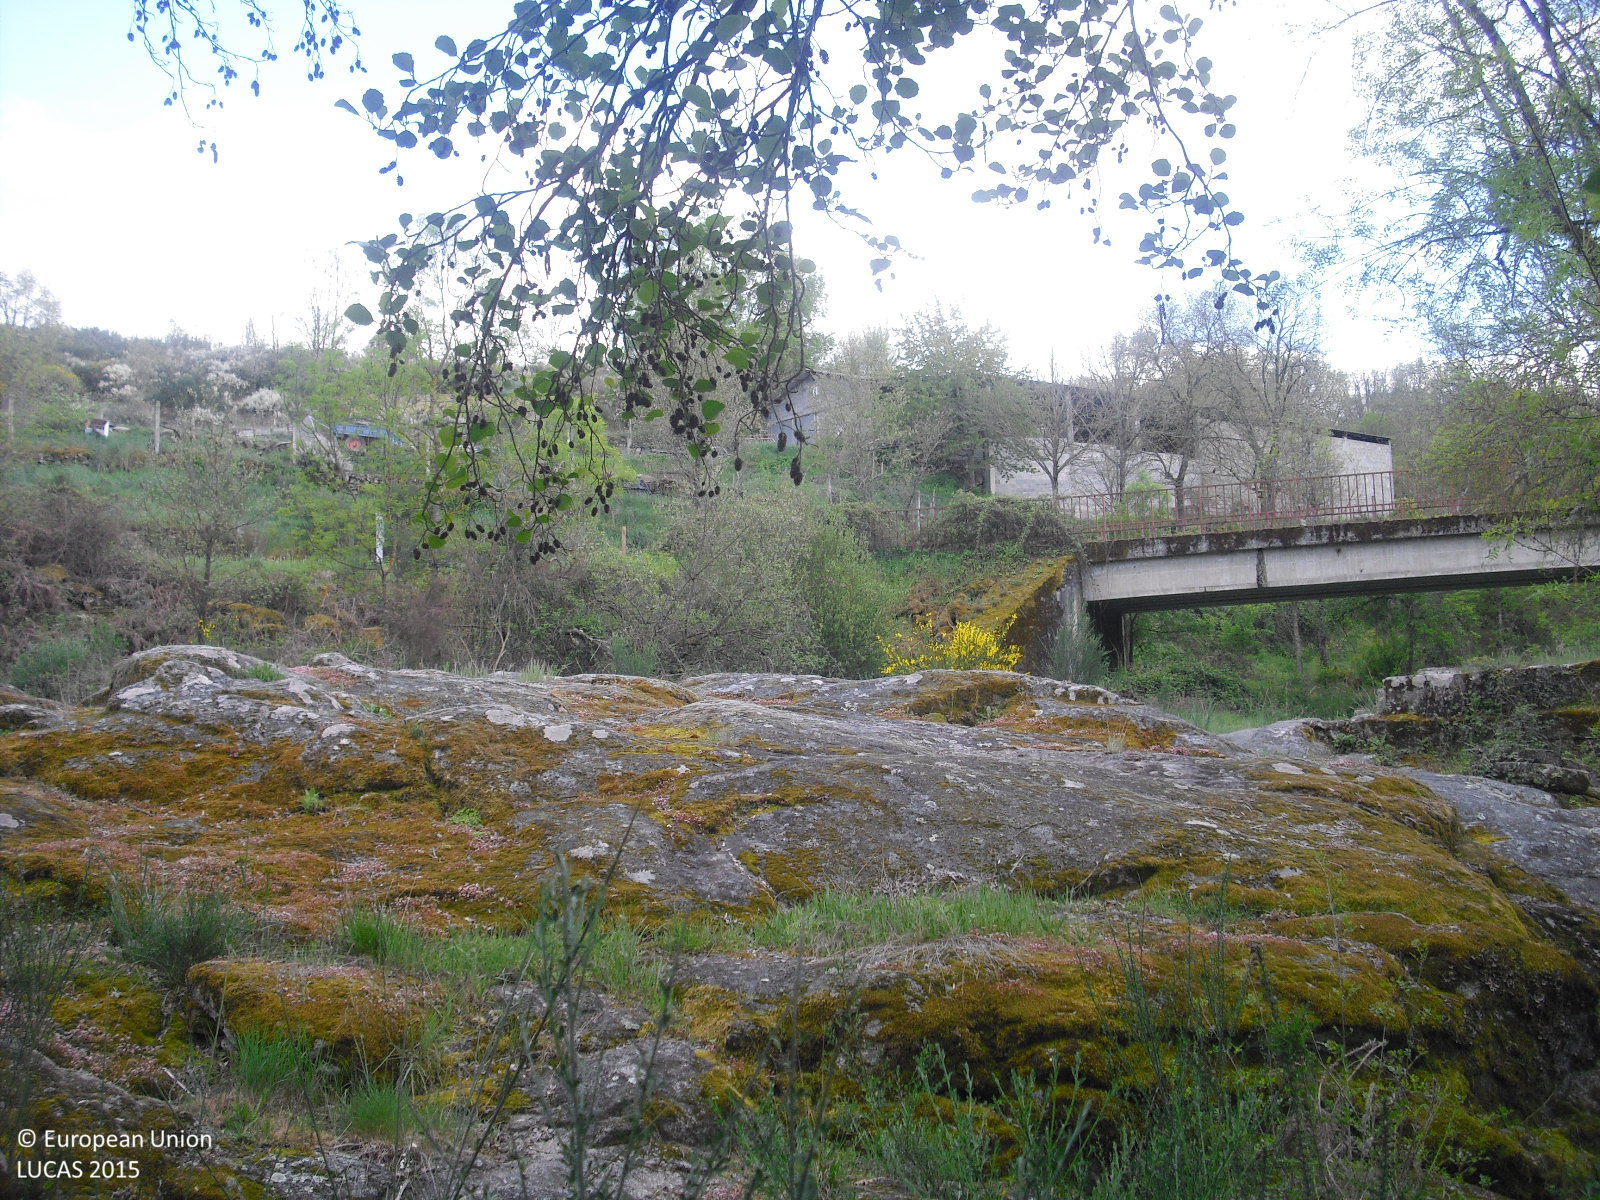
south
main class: Woodland
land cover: Broadleaved woodland
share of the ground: 25 - 50 %
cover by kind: broadleaved forest trees 30 %, herbaceous plants 30 %, shrubs 20 %, consolidated bare surface 20 %
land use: Amenities, museums, leisure
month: April
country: ES
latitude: 41.8865
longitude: -7.5240
